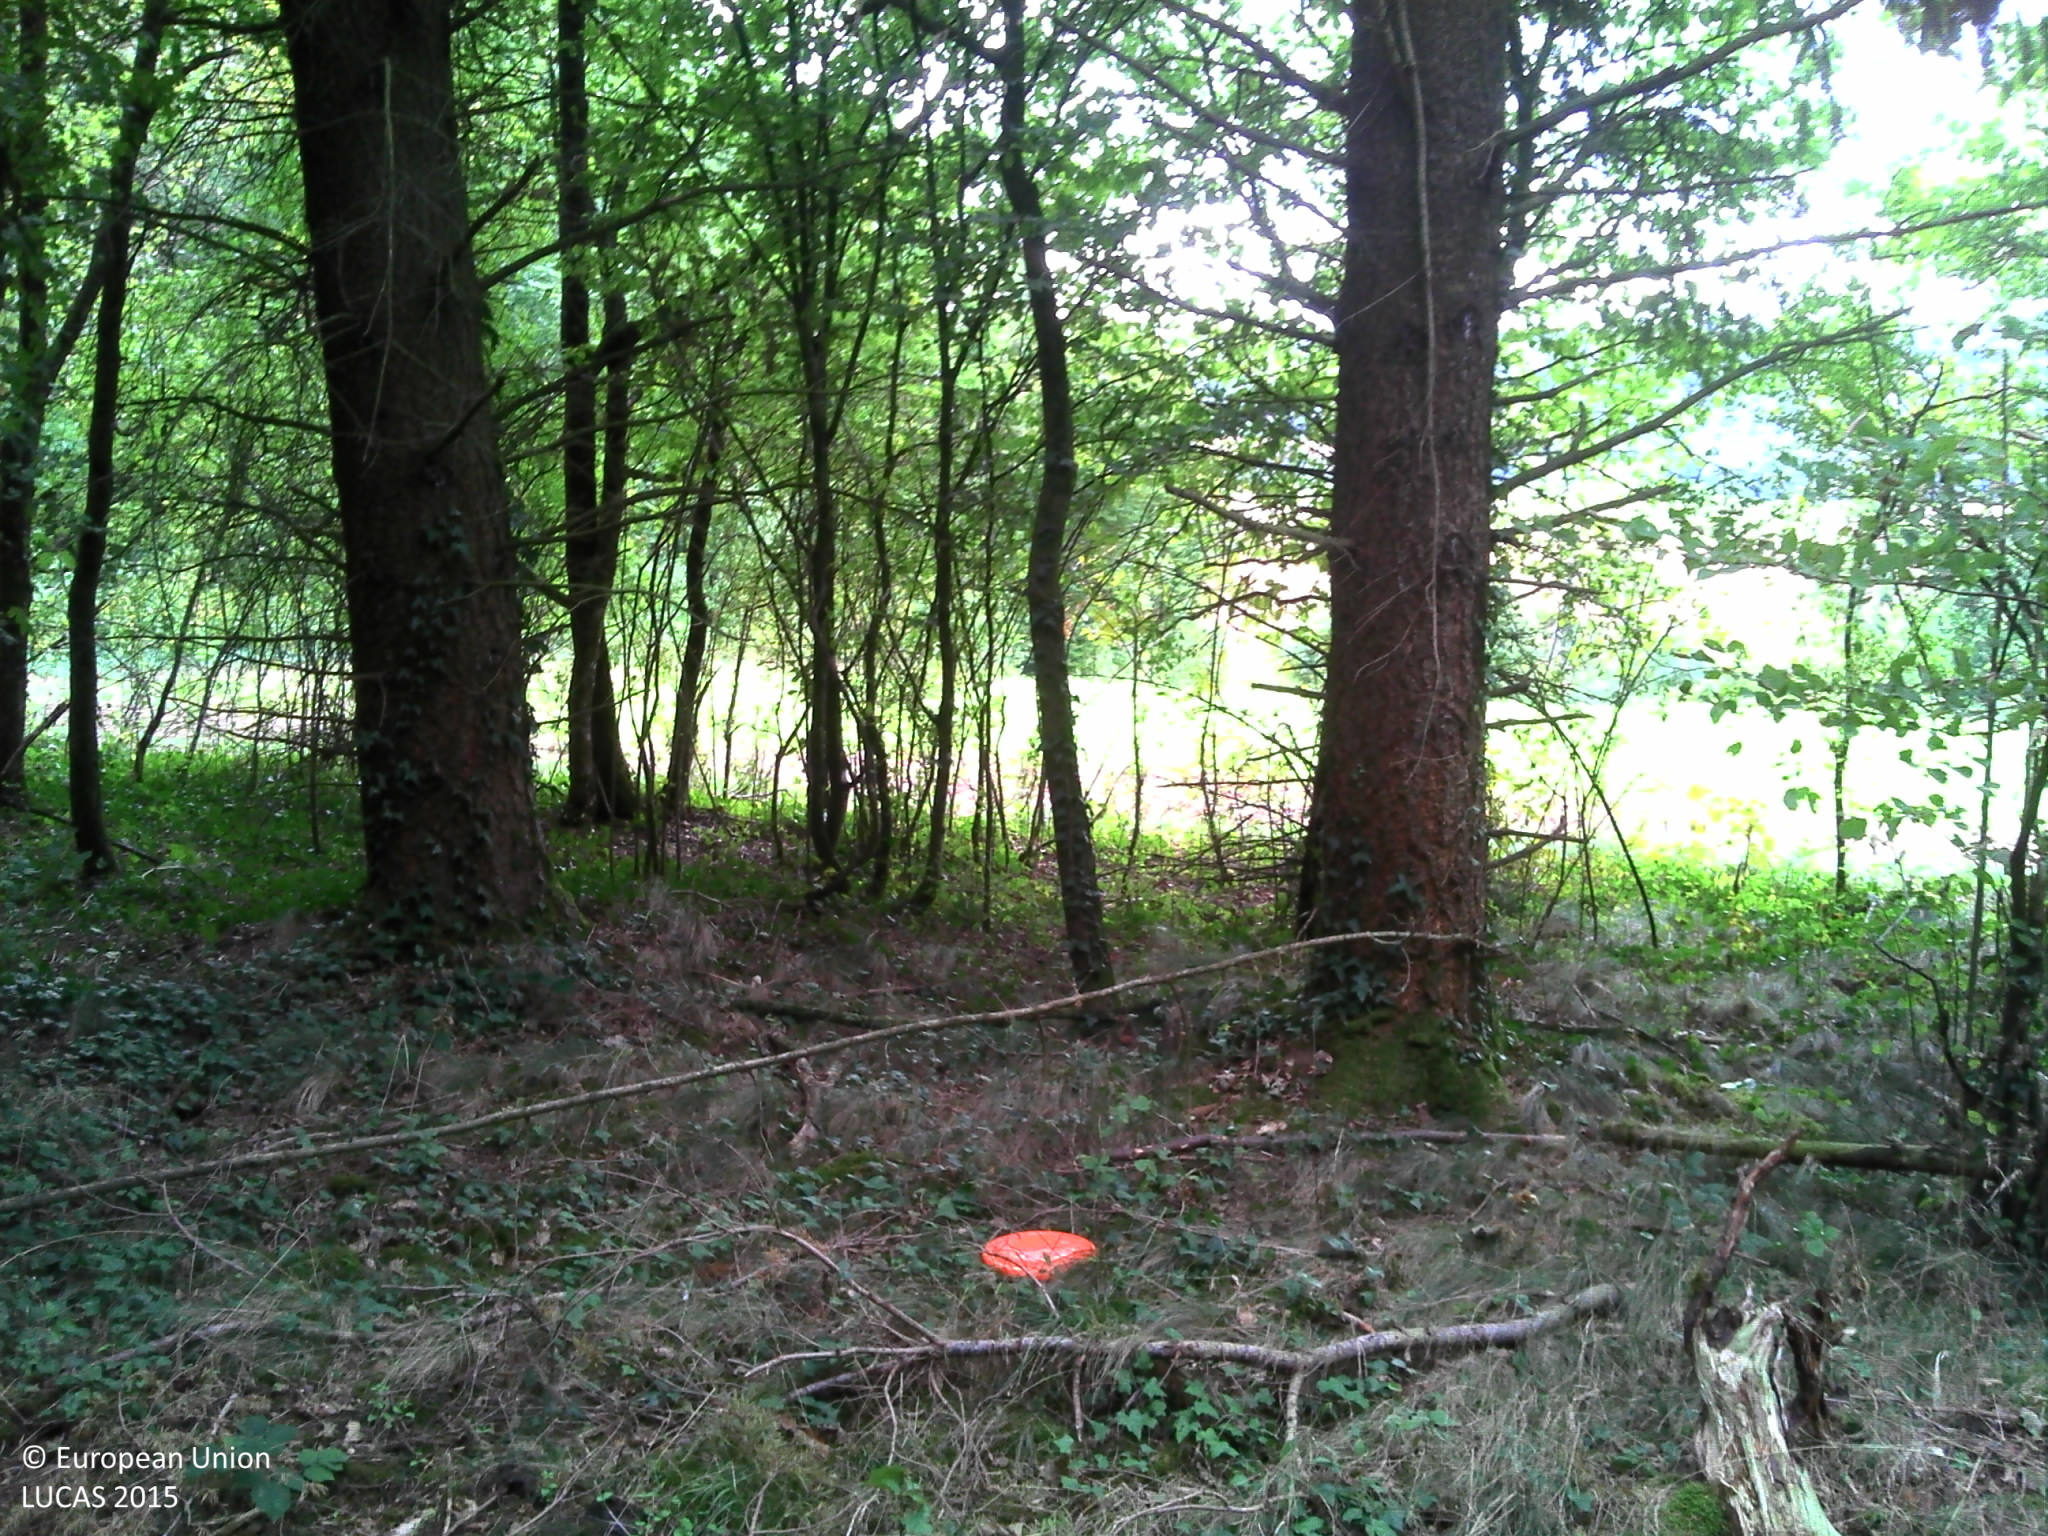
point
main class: Woodland
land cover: Other coniferous woodland
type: exotic forest
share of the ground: > 75 %
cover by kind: coniferous forest trees 85 %, broadleaved forest trees 5 %, herbaceous plants 5 %, lichens and mosses 5 %
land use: Forestry
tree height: > 5 m
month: September
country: FR
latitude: 48.2498
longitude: 3.8410
